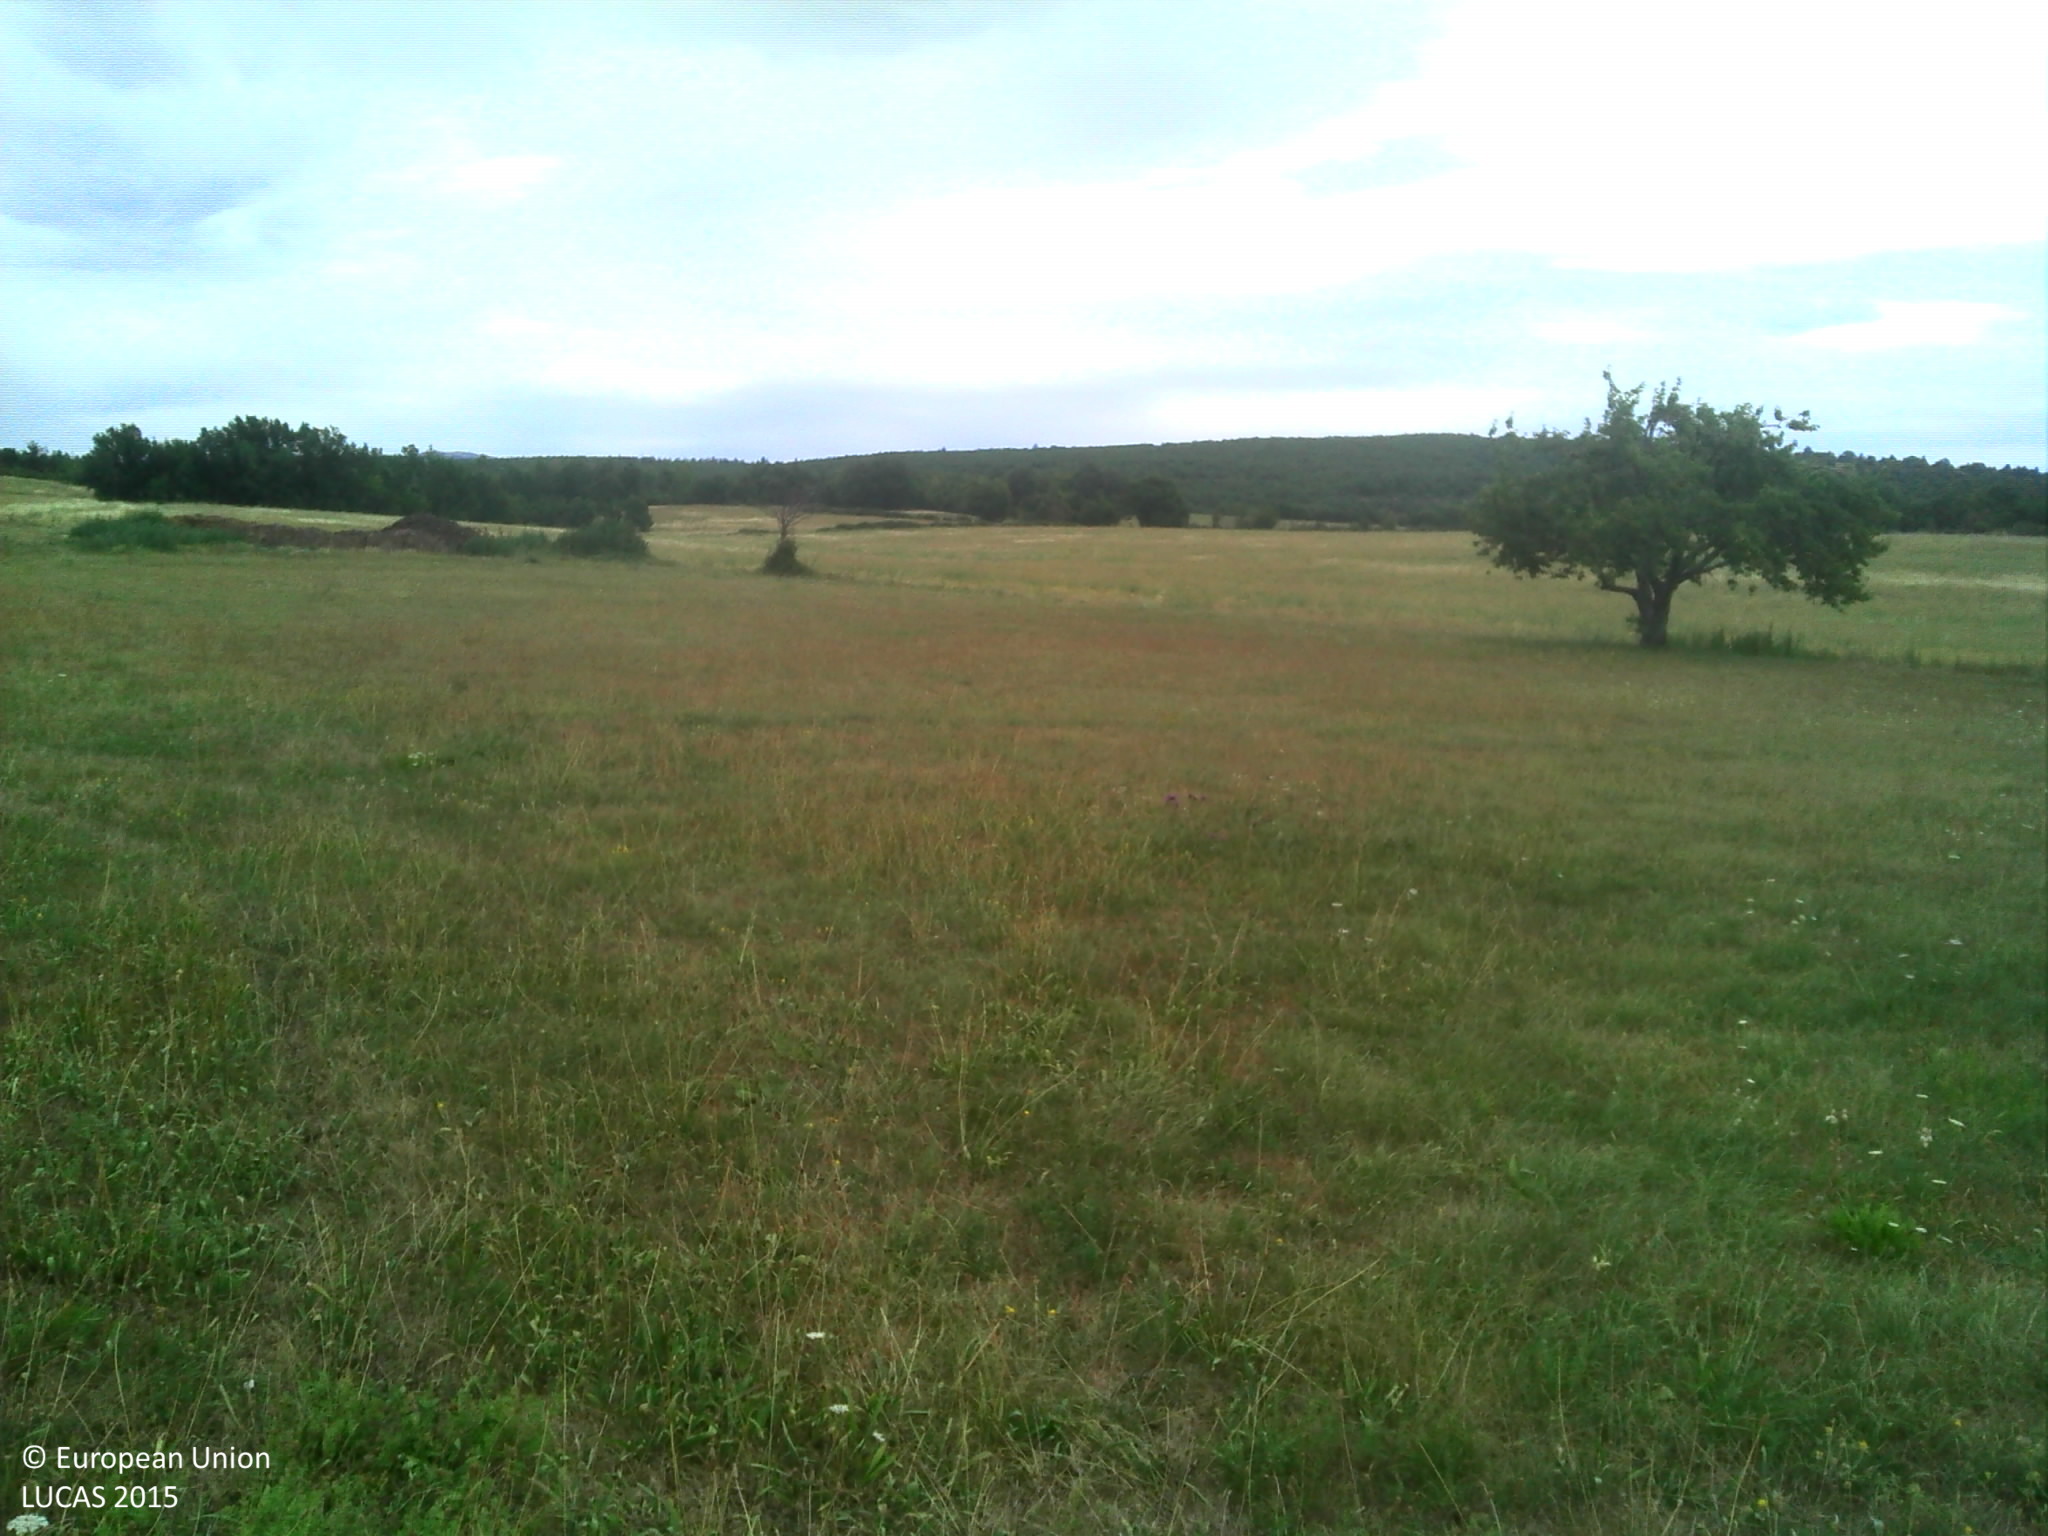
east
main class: Grassland
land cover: Grassland without tree/shrub cover
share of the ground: > 75 %
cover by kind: herbaceous plants 100 %
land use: Agriculture (excluding fallow land and kitchen gardens)
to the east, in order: Grassland without tree/shrub cover; Single bushes/trees; Grass margins; Spontaneously vegetated surfaces
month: July
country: FR
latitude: 44.0385
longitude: 5.5532
